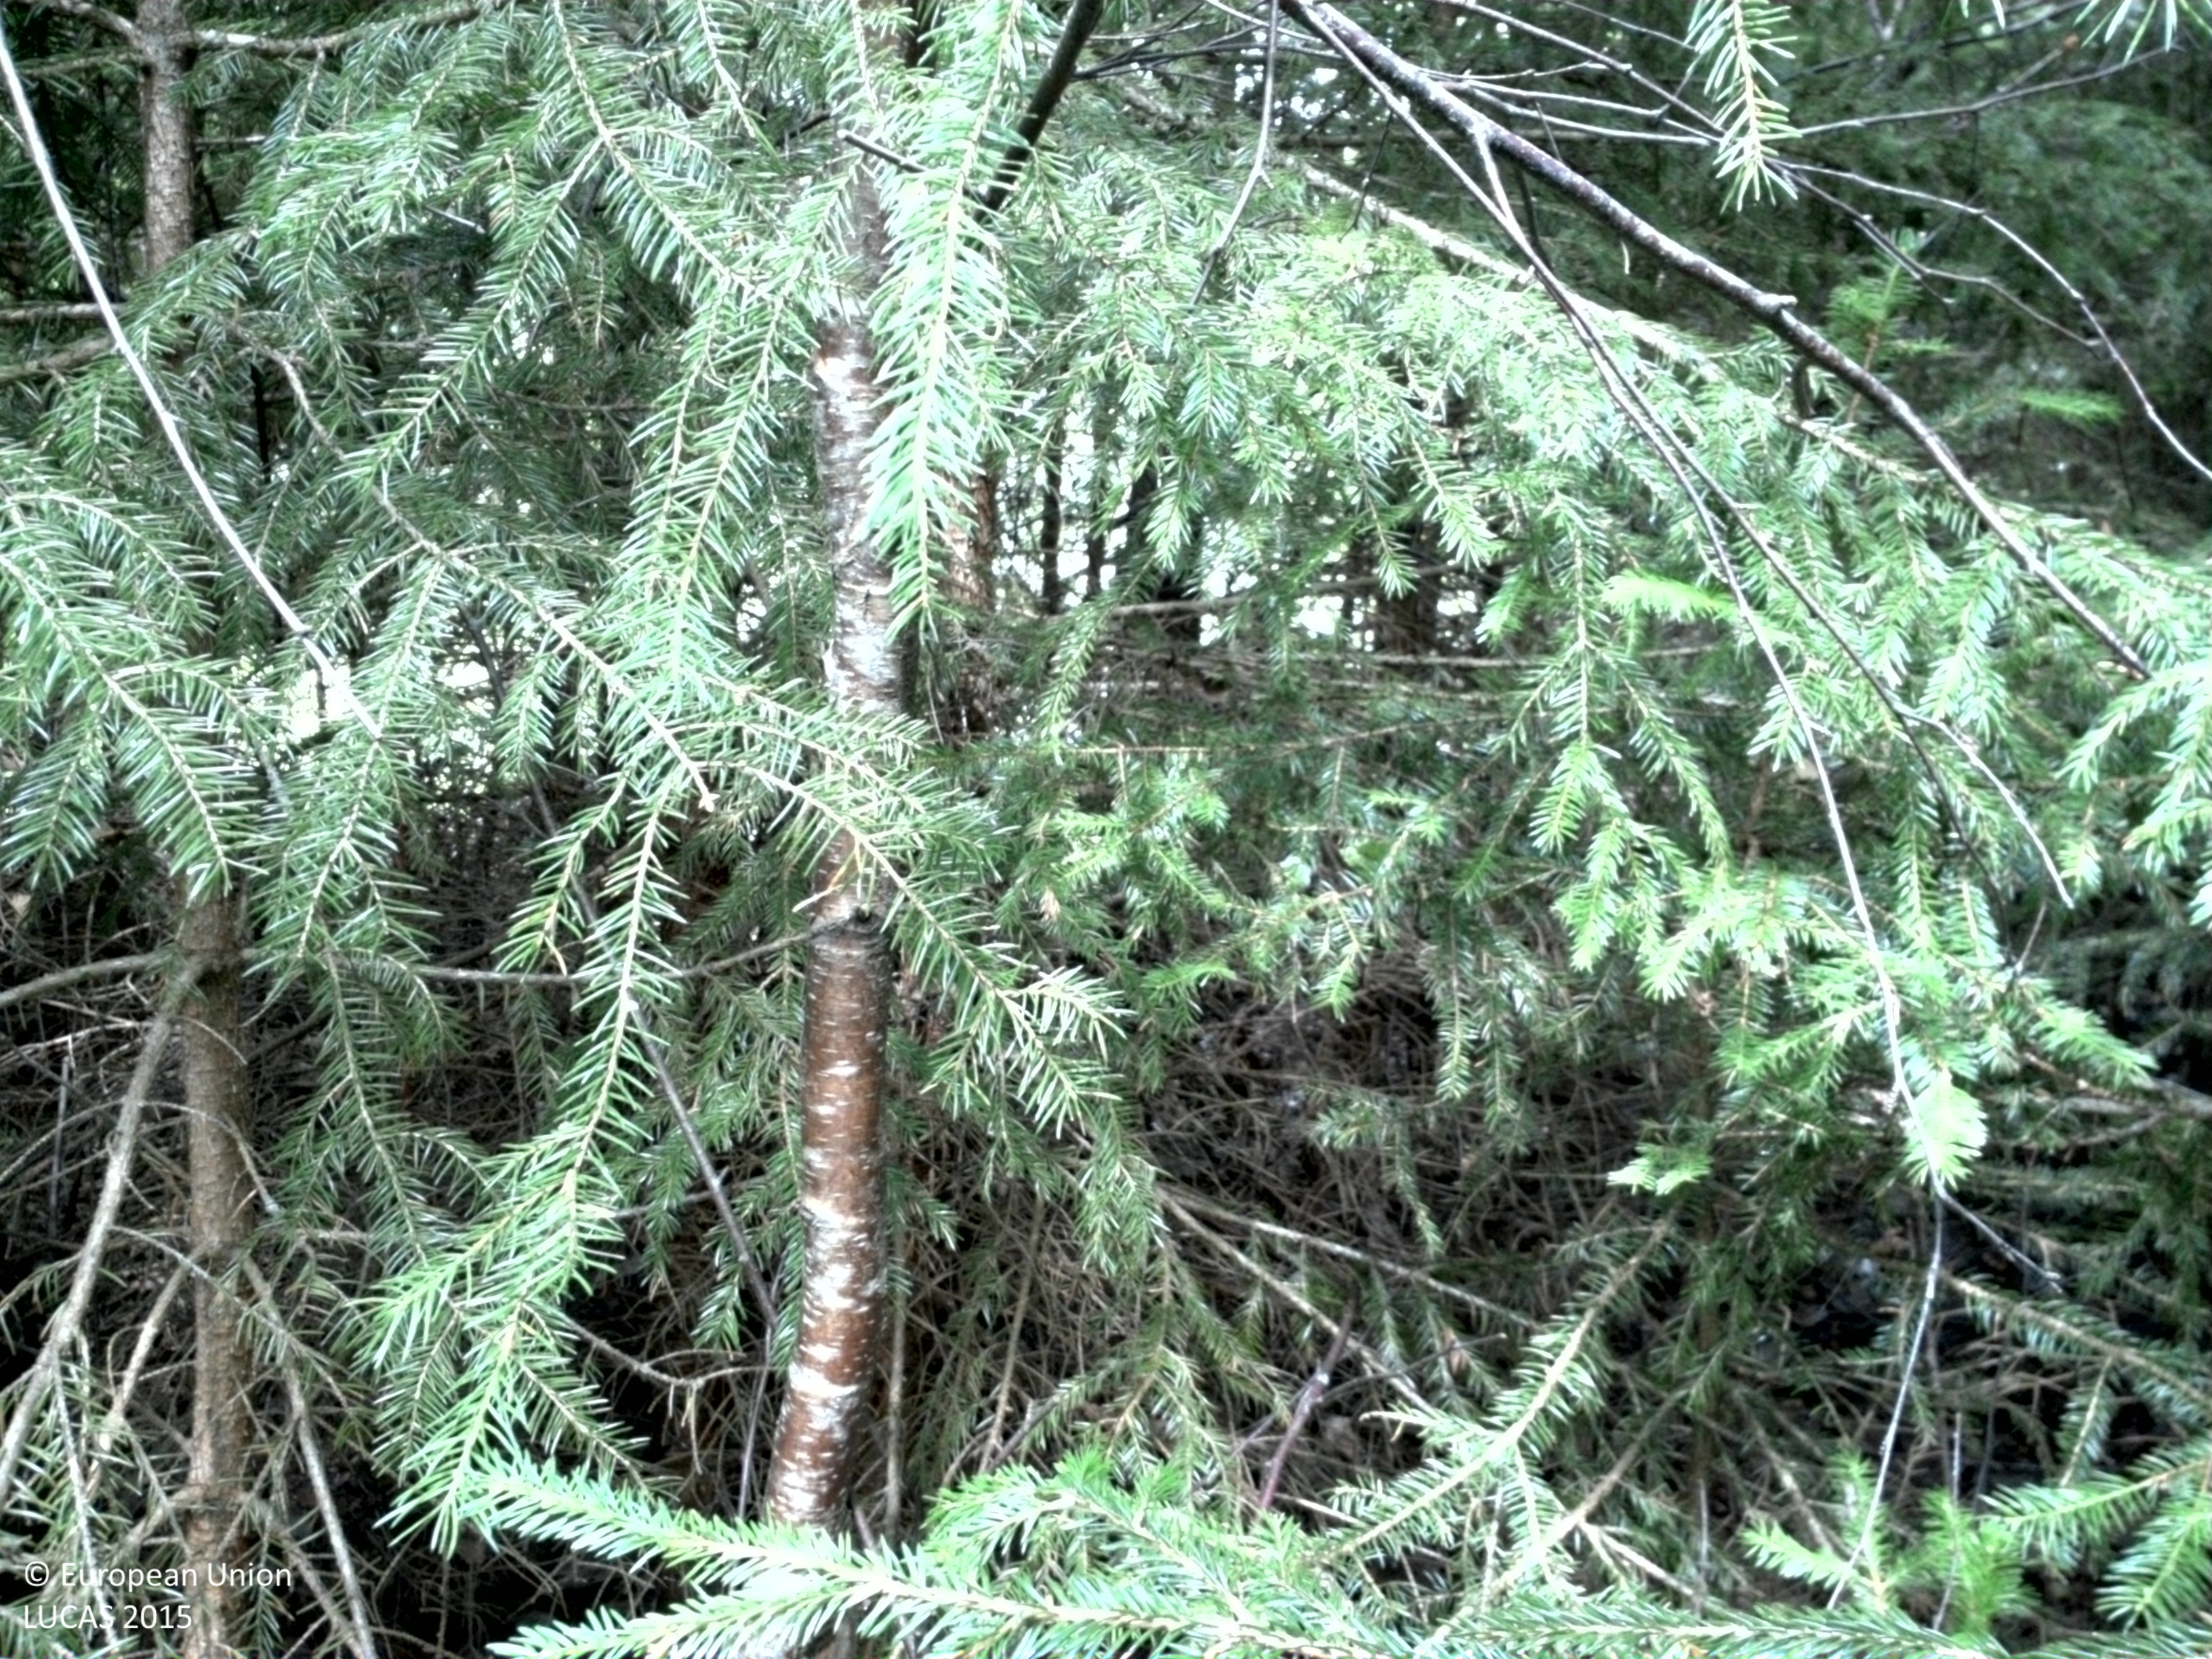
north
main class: Woodland
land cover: Spruce dominated mixed woodland
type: boreal forest
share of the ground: 50 - 75 %
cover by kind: coniferous forest trees 45 %, broadleaved forest trees 25 %, herbaceous plants 25 %, lichens and mosses 5 %
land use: Forestry
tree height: > 5 m
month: July
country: SE
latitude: 58.8274
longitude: 14.5481
